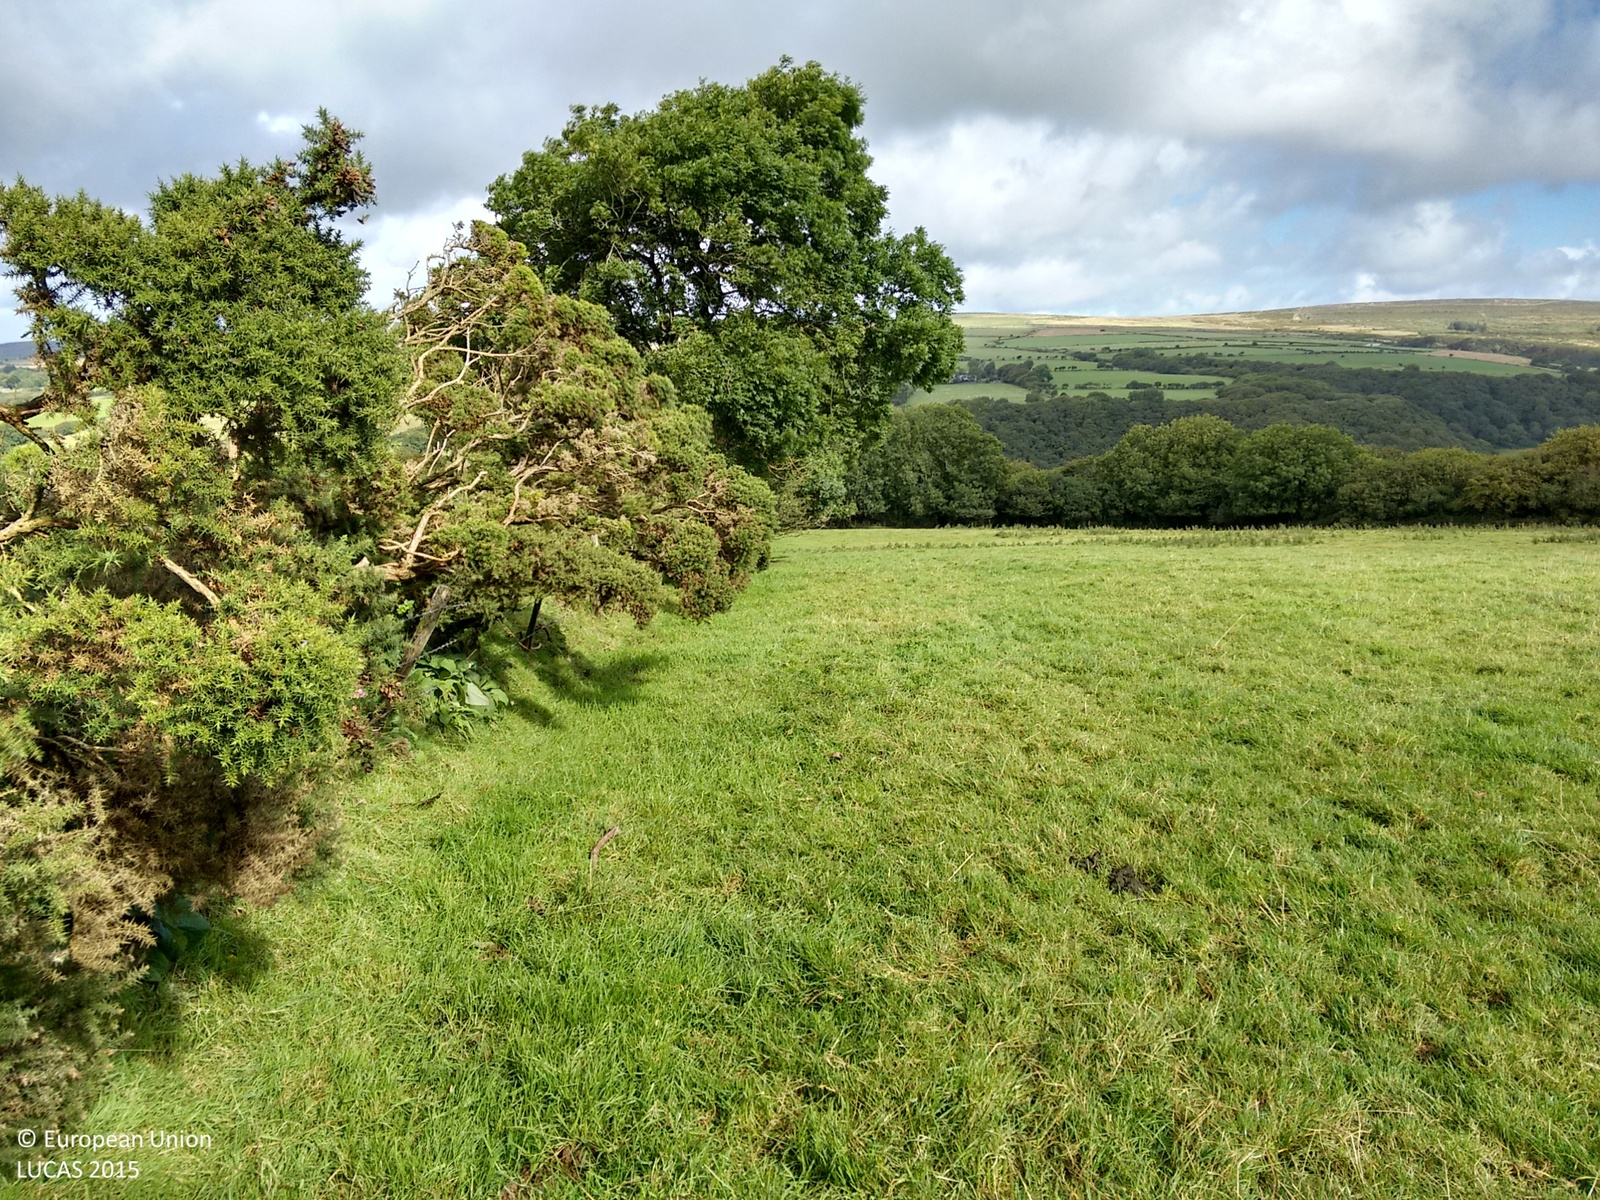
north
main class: Grassland
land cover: Grassland without tree/shrub cover
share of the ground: > 75 %
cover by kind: herbaceous plants 100 %
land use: Agriculture (excluding fallow land and kitchen gardens)
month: August
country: GB
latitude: 51.9658
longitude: -4.8577
